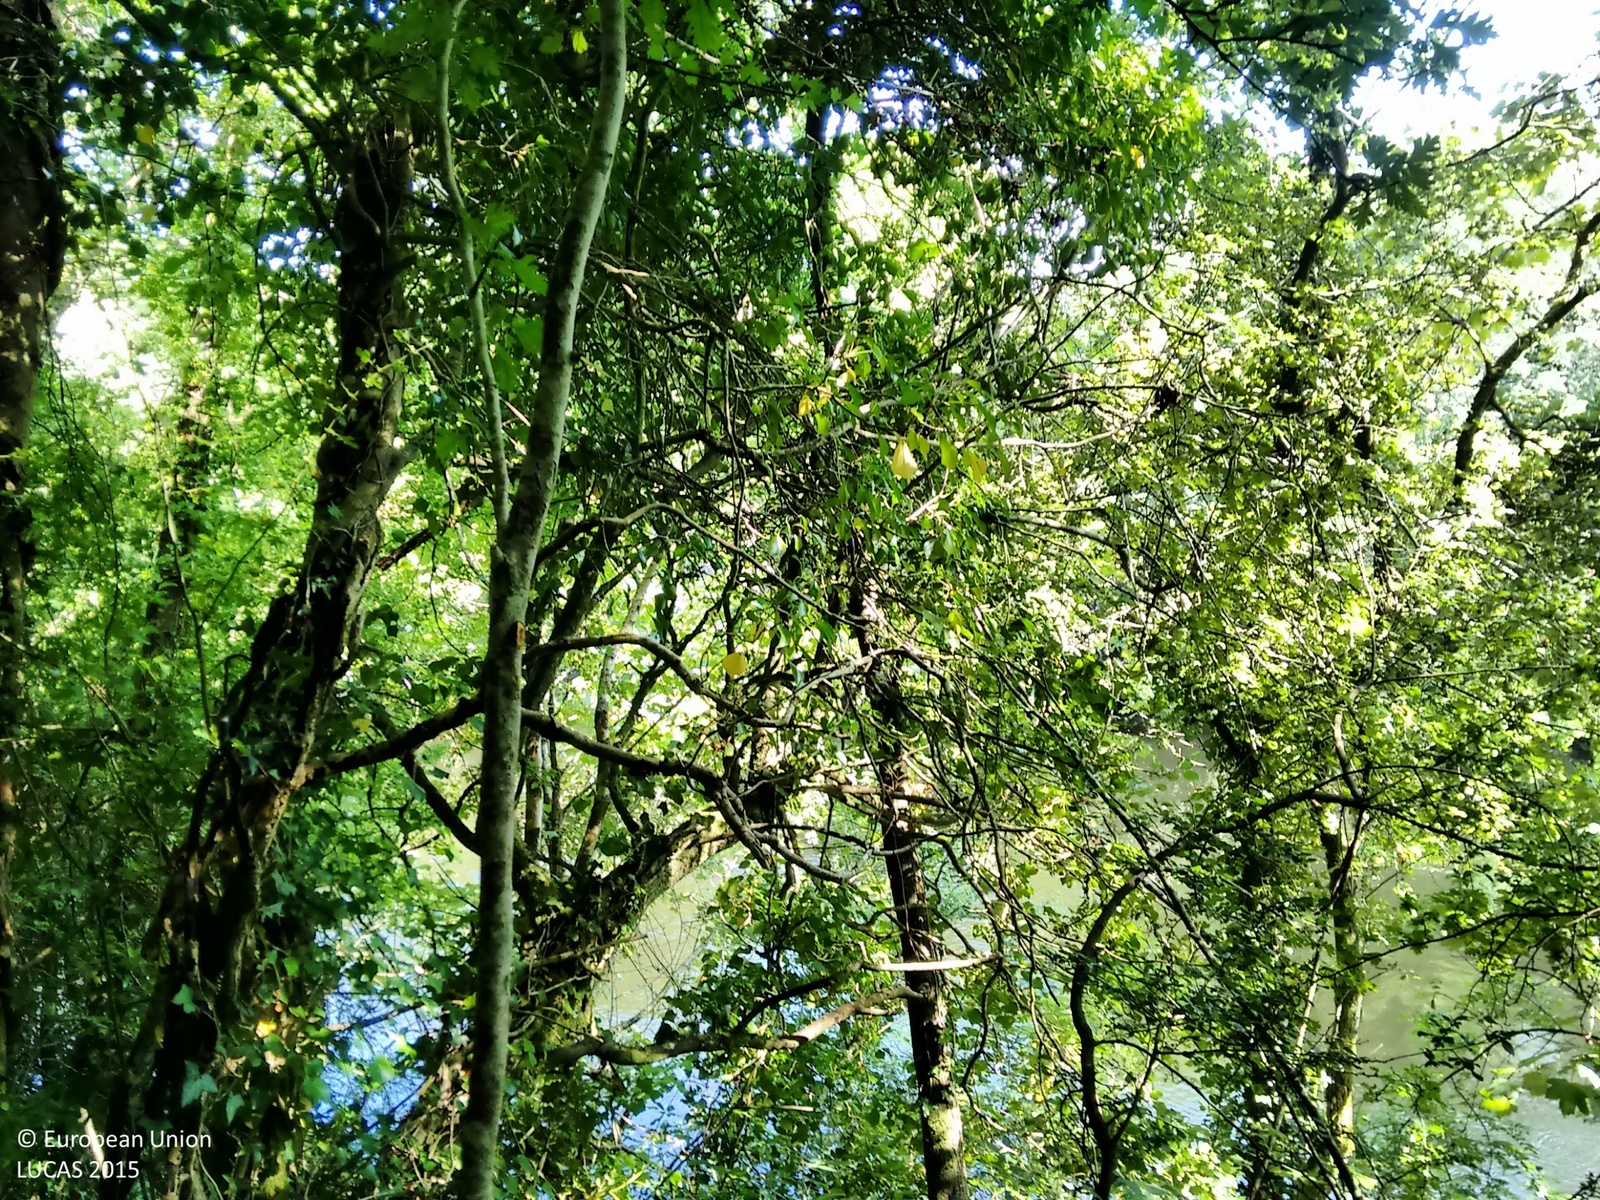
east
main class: Woodland
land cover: Broadleaved woodland
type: acidophilous oak and oak-birch forest
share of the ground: > 75 %
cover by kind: broadleaved forest trees 95 %, herbaceous plants 5 %
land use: Semi-natural and natural areas not in use
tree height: > 5 m
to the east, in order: Broadleaved woodland; Inland fresh running water; Broadleaved woodland; Fences; Grassland without tree/shrub cover; Fences; Managed hedges; Grassland with sparse tree/shrub cover; Managed hedges; Fences; Grassland without tree/shrub cover
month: September
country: IE
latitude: 52.6960
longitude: -8.6204
